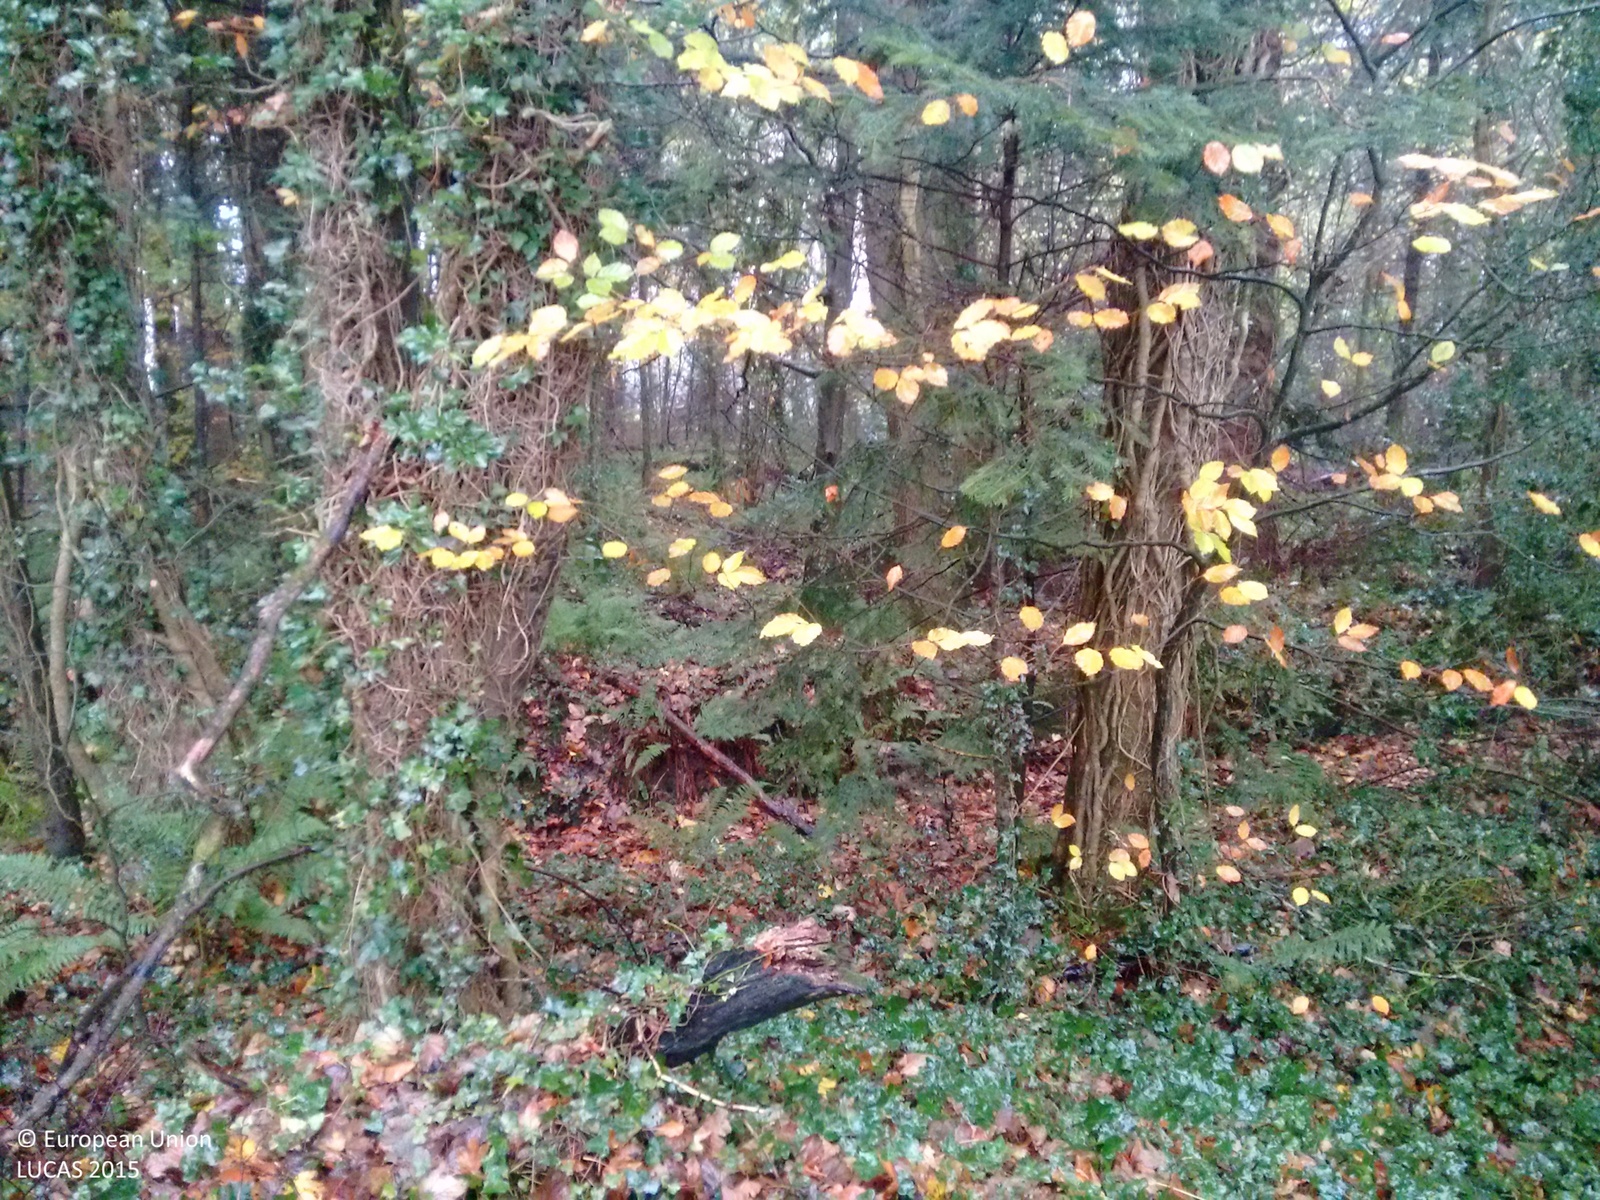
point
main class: Woodland
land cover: Broadleaved woodland
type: acidophilous oak and oak-birch forest
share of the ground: > 75 %
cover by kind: broadleaved forest trees 95 %, shrubs 5 %
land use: Semi-natural and natural areas not in use
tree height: > 5 m
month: November
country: IE
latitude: 53.8885
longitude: -7.8332
